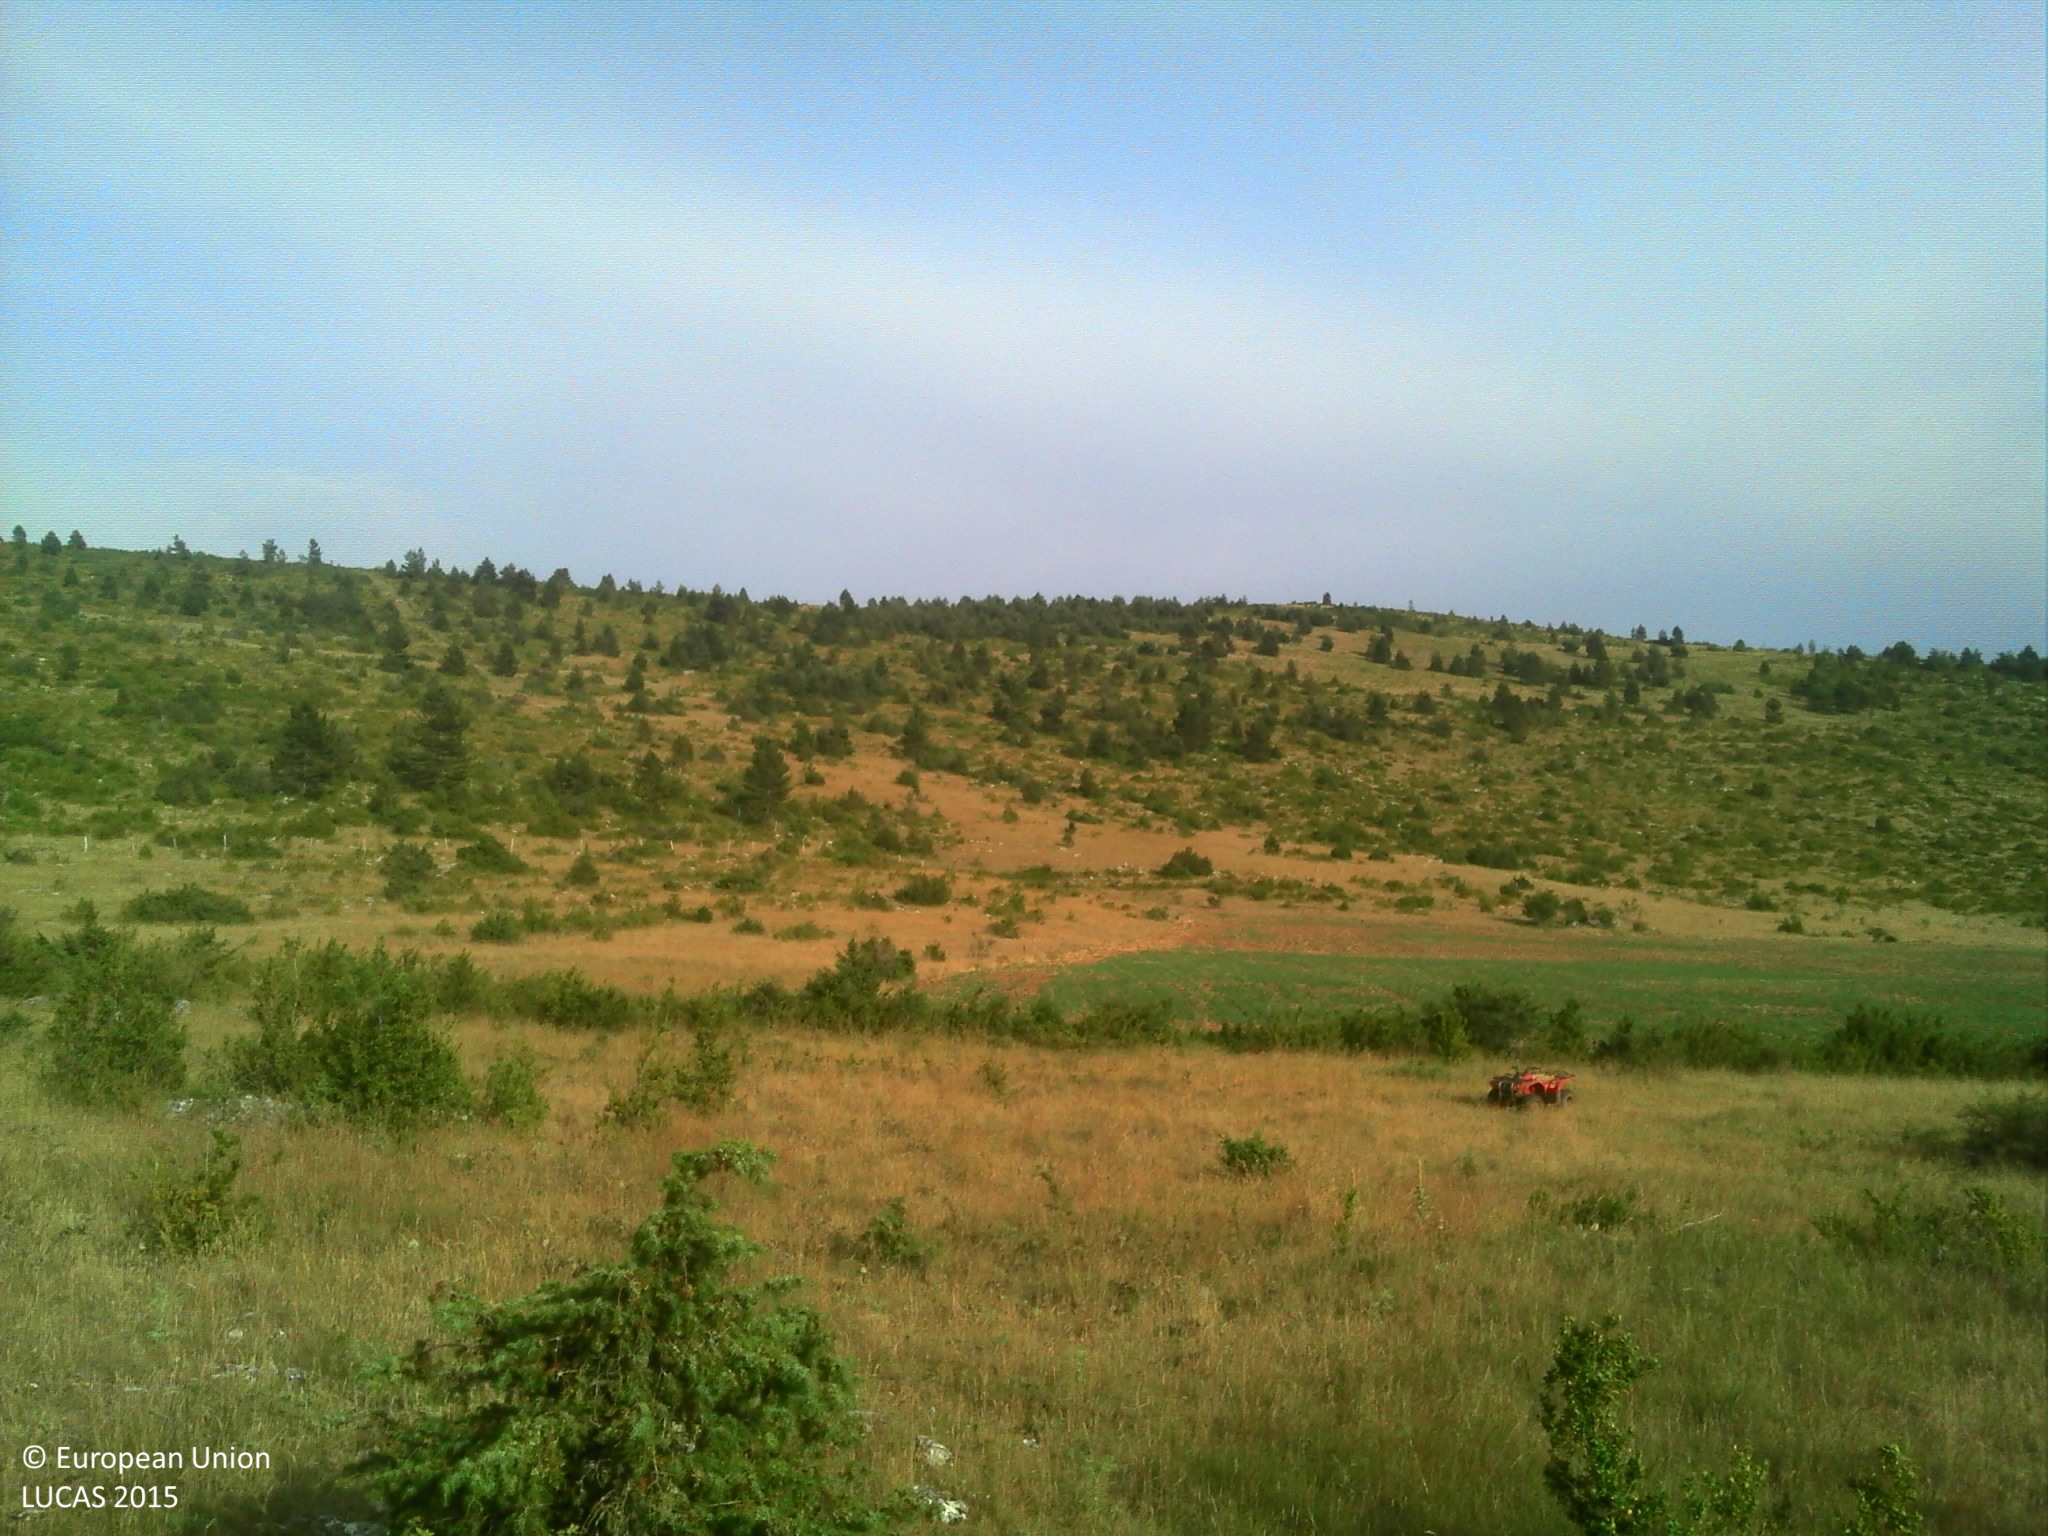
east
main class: Shrubland
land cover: Shrubland with sparse tree cover
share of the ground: > 75 %
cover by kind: shrubs 45 %, herbaceous plants 45 %, coniferous forest trees 5 %
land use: Semi-natural and natural areas not in use
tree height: < 5 m
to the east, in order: Shrubland with sparse tree cover; Tracks; Shrubland with sparse tree cover; Fences; Shrubland with sparse tree cover
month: July
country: FR
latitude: 44.3306
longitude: 3.5475
